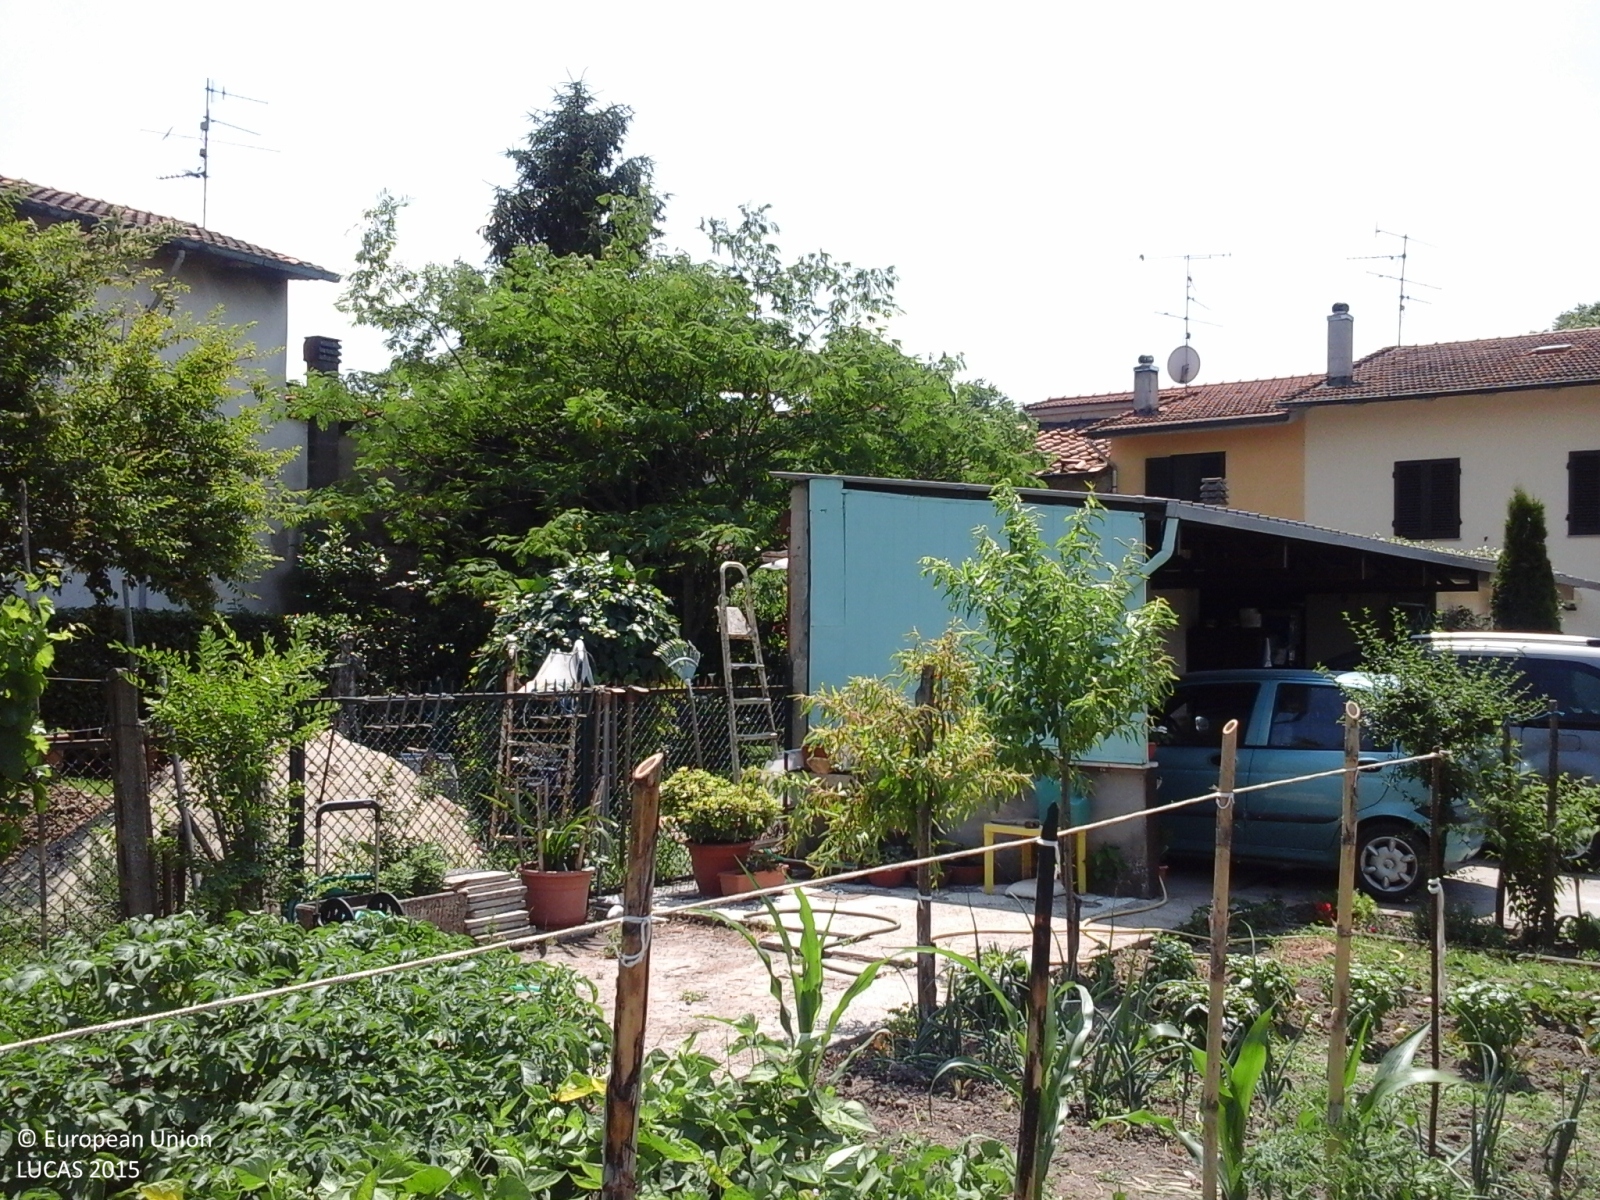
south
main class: Cropland
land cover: Other fresh vegetables
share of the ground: > 75 %
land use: Kitchen garden
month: June
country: IT
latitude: 43.8942
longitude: 11.0555
